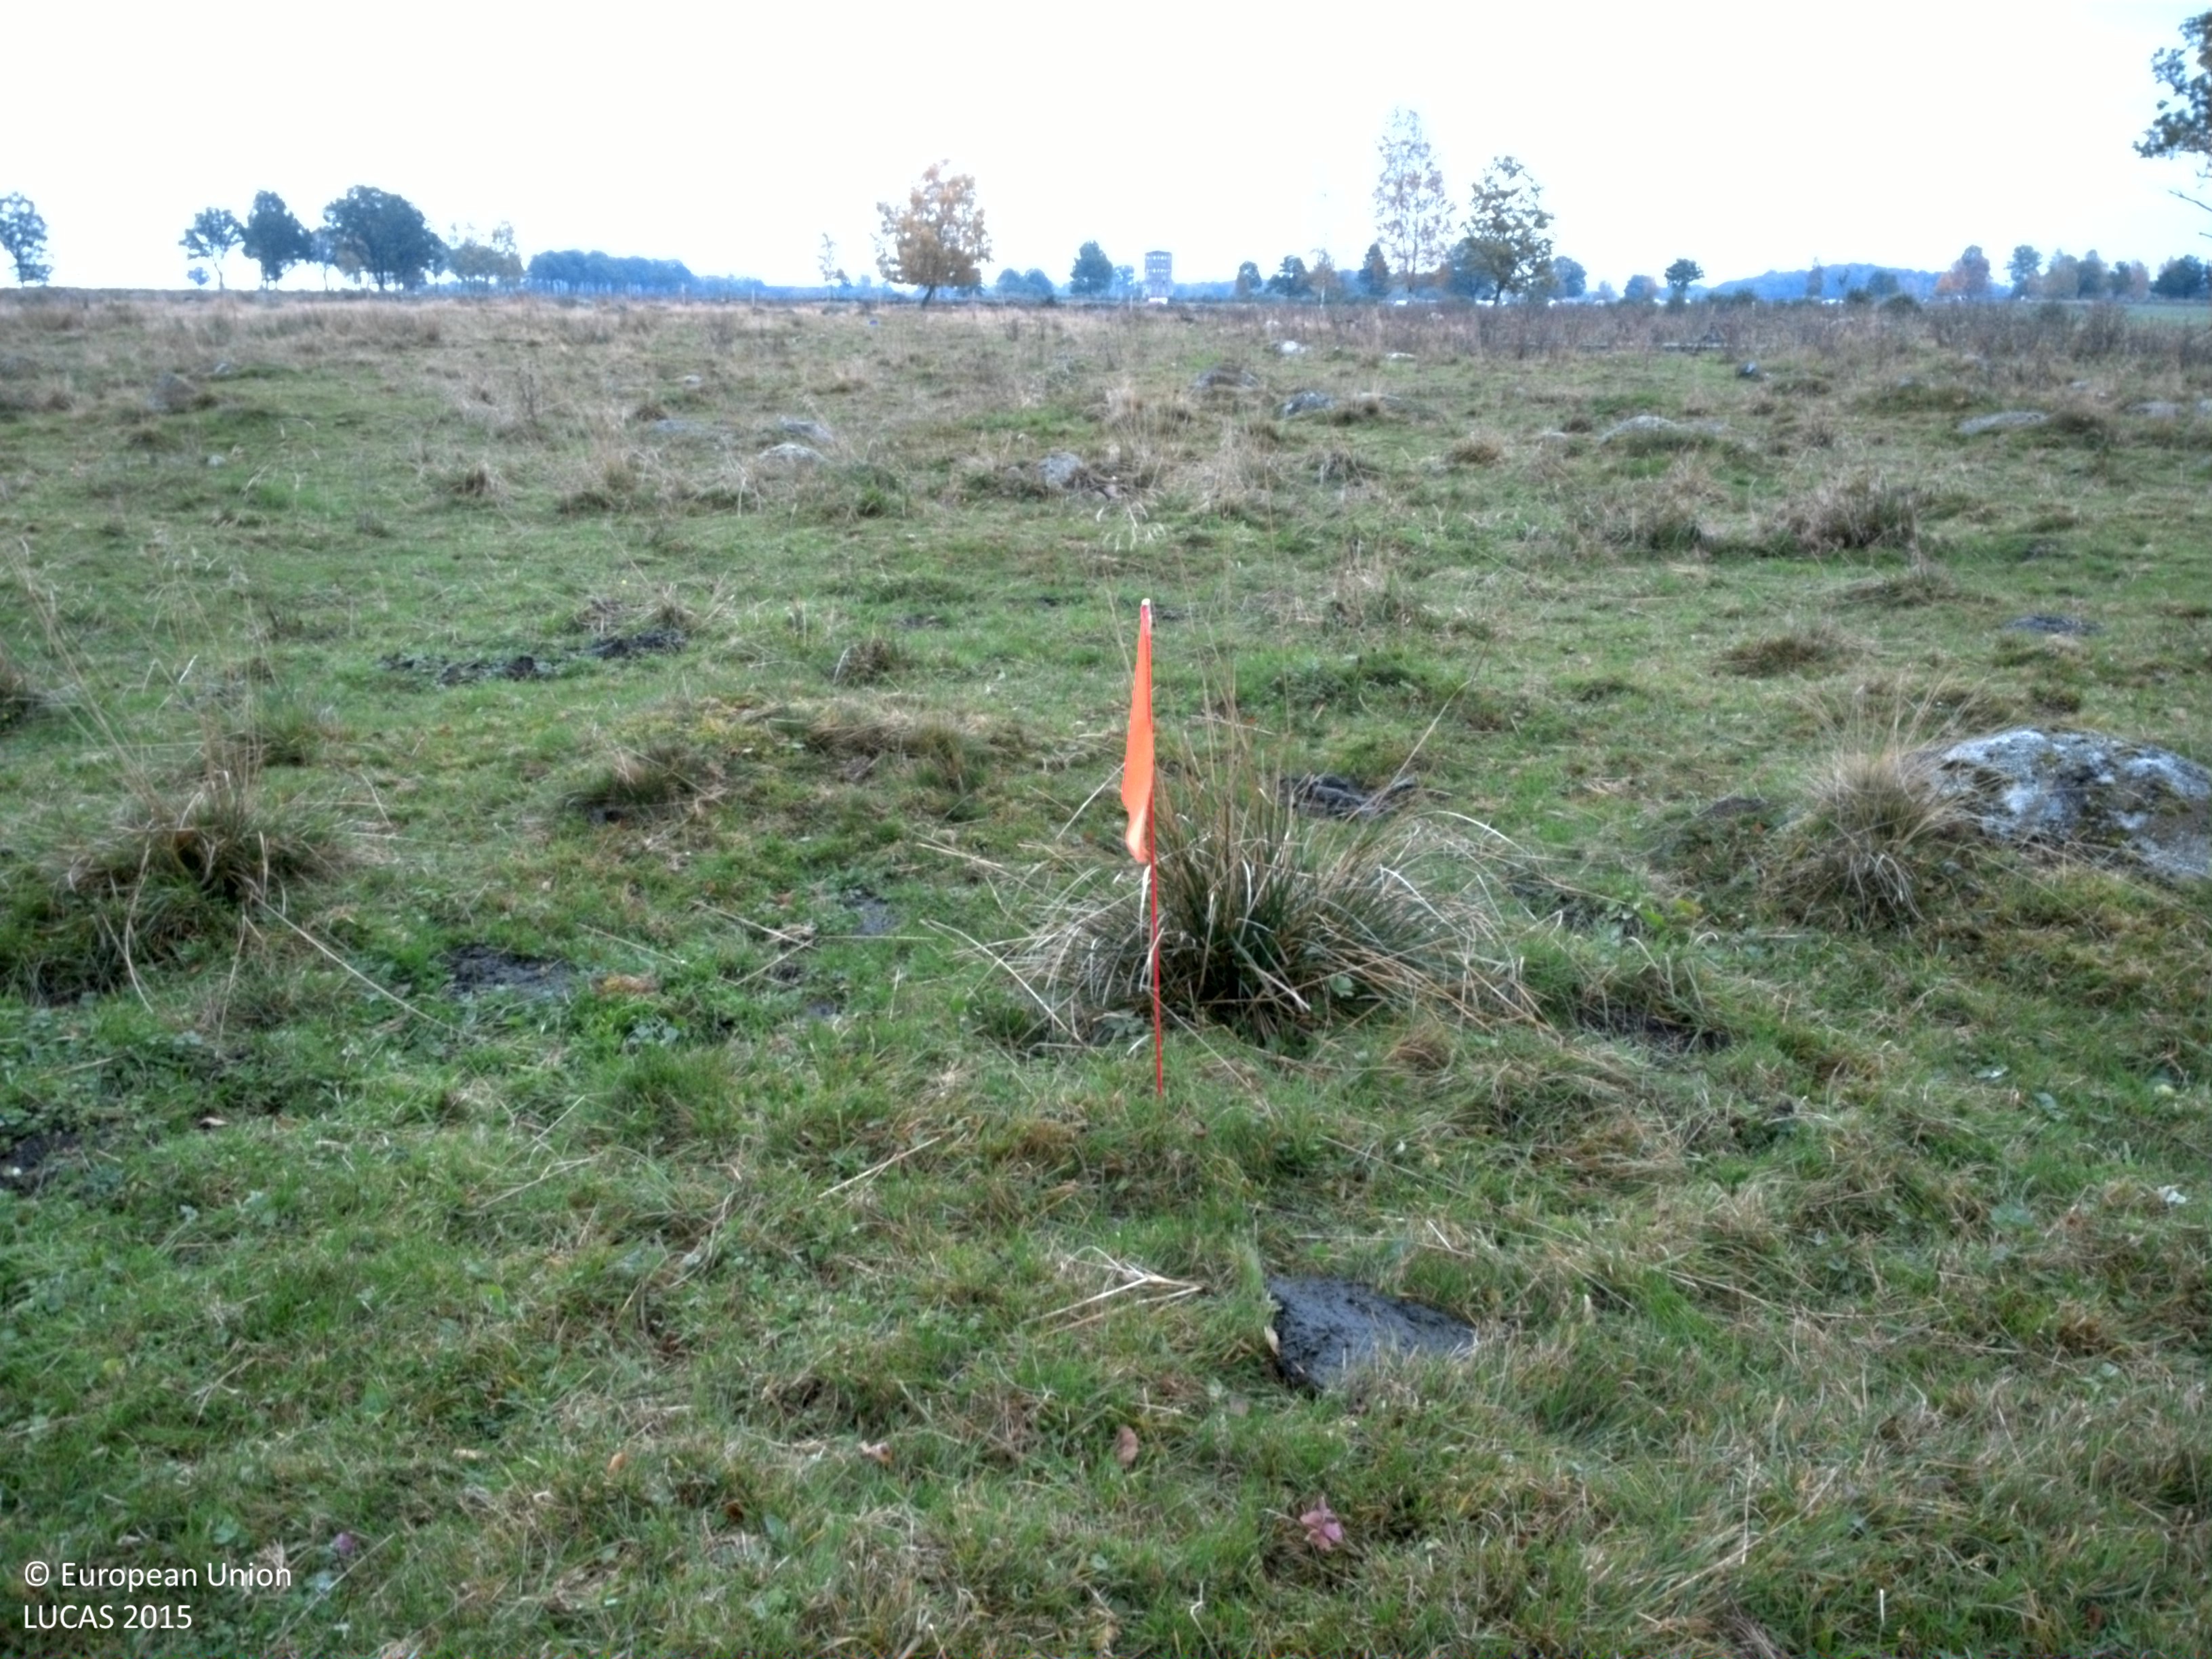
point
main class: Grassland
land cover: Grassland without tree/shrub cover
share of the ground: > 75 %
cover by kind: herbaceous plants 100 %
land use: Agriculture (excluding fallow land and kitchen gardens)
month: October
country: SE
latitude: 55.8101
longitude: 13.7158
